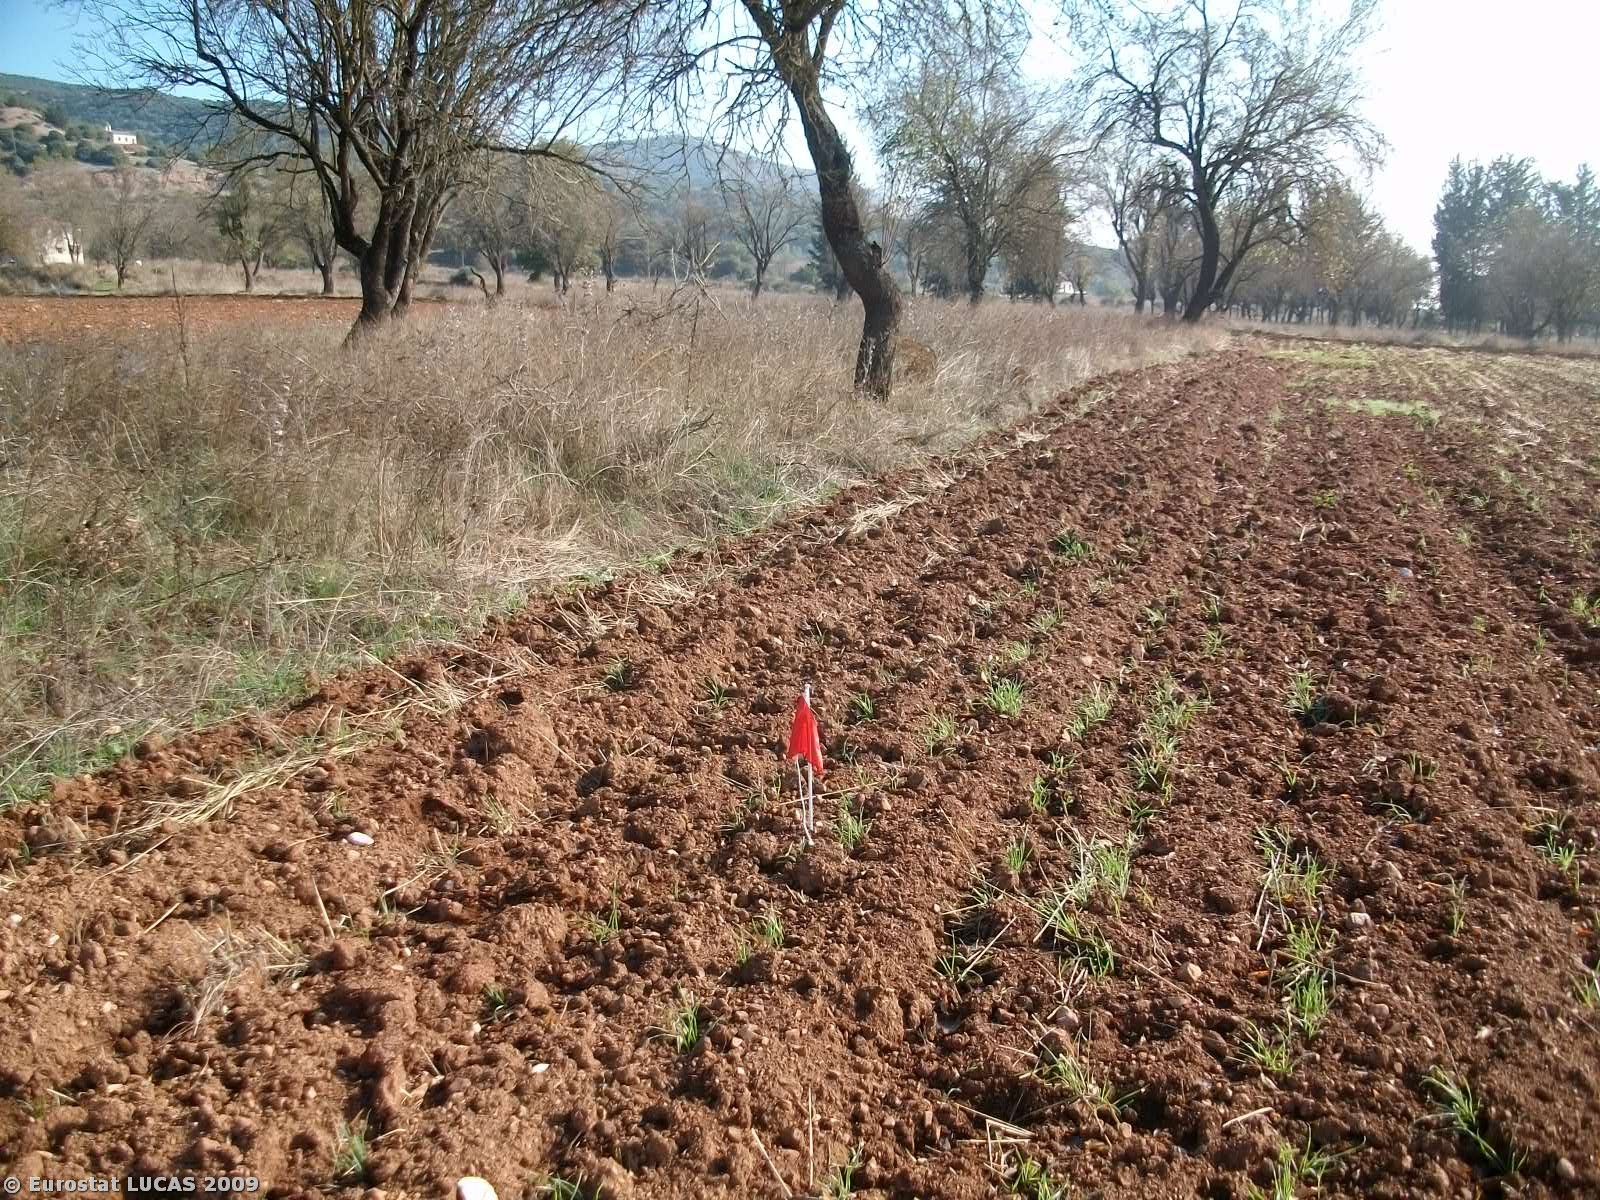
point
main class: Bare land
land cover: Bare land
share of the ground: > 75 %
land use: Fallow land
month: October
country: GR
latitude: 38.0367
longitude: 22.0784
